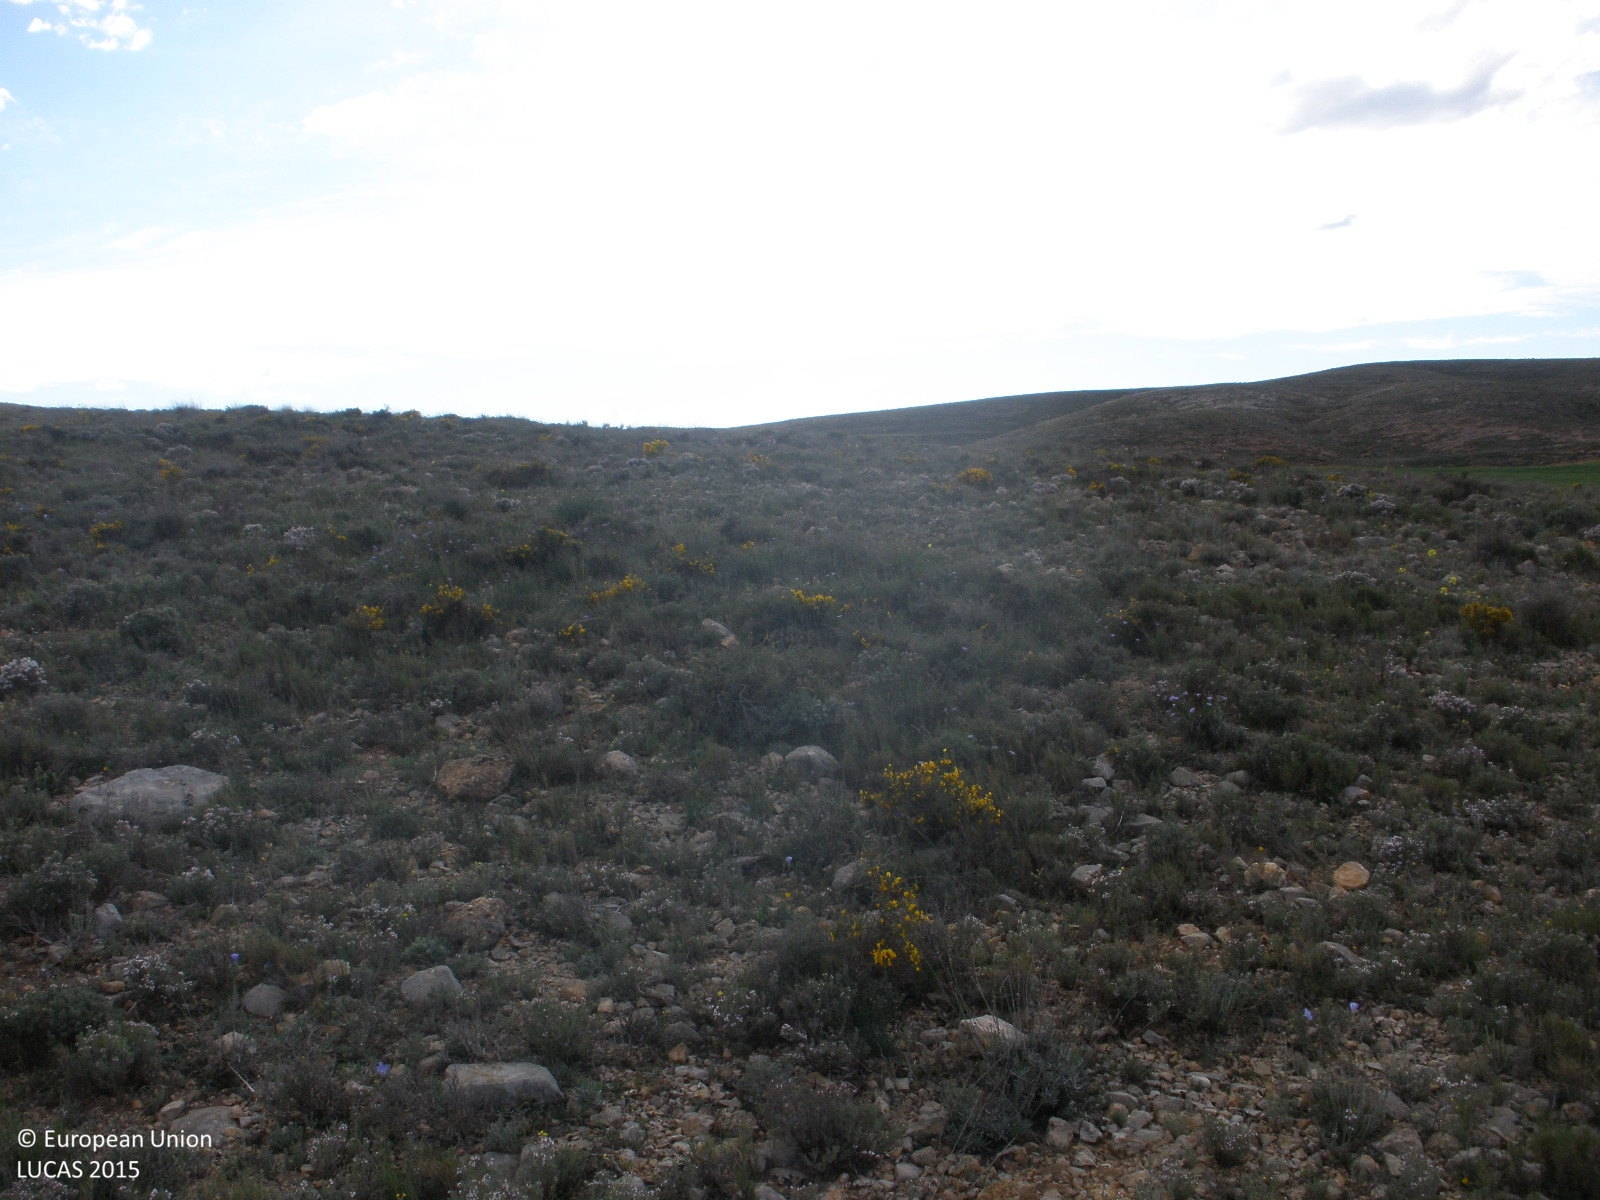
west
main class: Shrubland
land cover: Shrubland without tree cover
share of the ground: 50 - 75 %
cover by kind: shrubs 50 %, herbaceous plants 35 %, consolidated bare surface 15 %
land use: Semi-natural and natural areas not in use
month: May
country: ES
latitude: 41.0642
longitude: -0.8810
